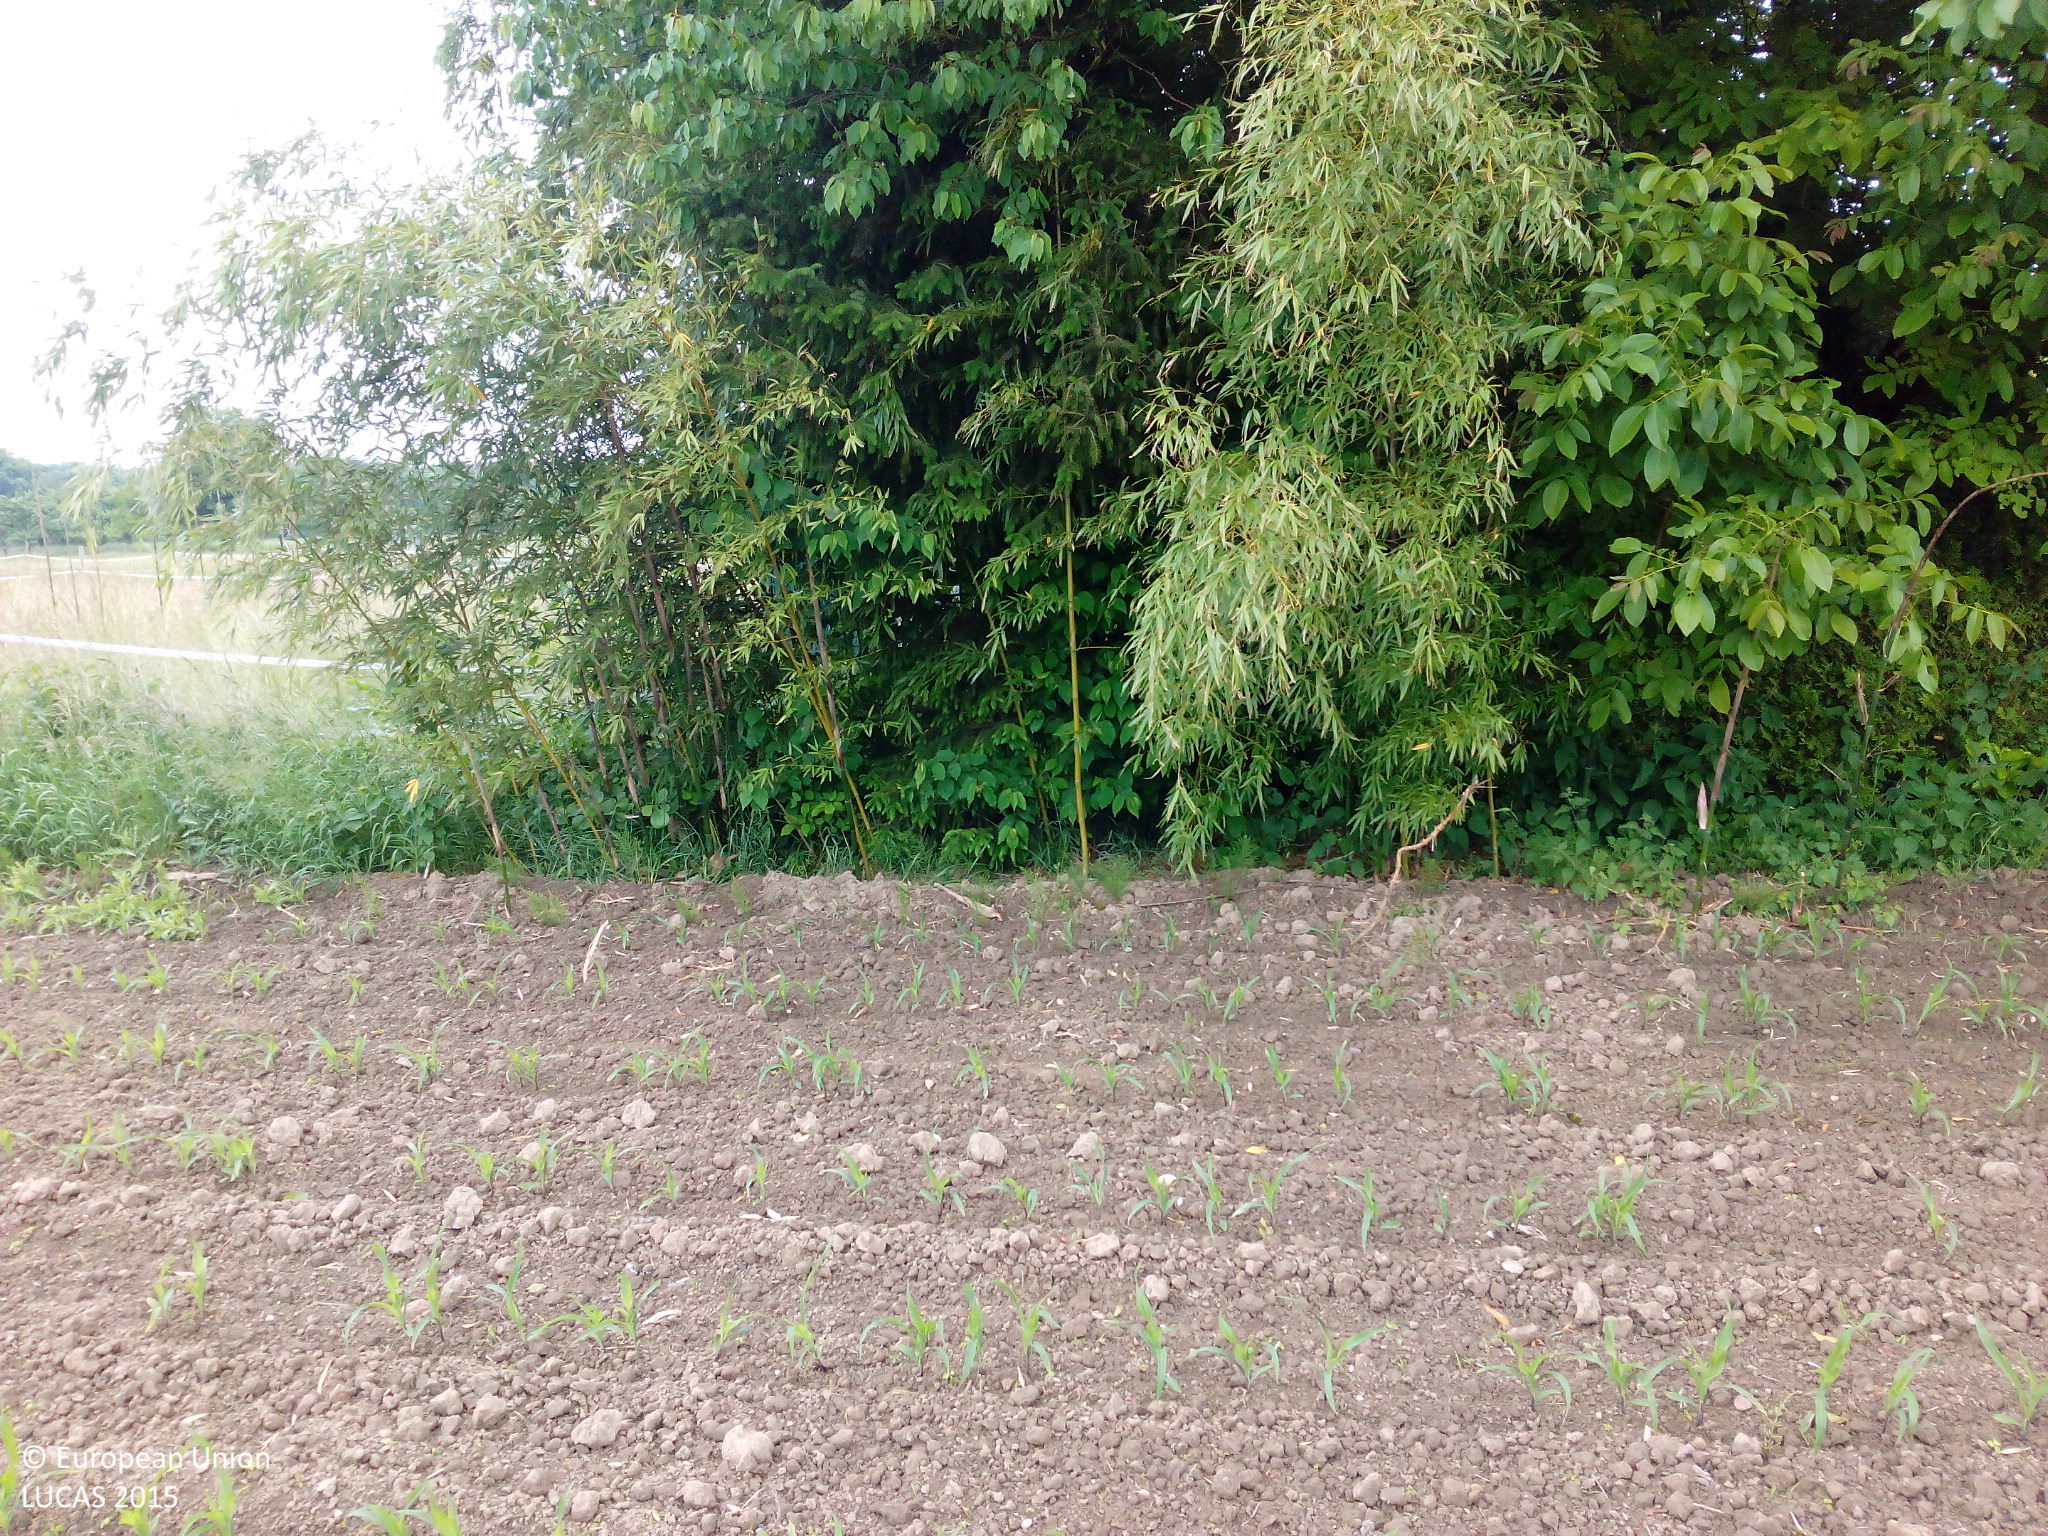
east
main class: Cropland
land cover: Maize
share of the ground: < 10 %
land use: Agriculture (excluding fallow land and kitchen gardens)
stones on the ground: < 10 %
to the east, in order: Maize; Broadleaved woodland; Fences; Grassland without tree/shrub cover; Fences; Paved roads, cycling and walking lanes; Common wheat; Apple fruit; Maize; Grassland without tree/shrub cover; Maize; Grassland with sparse tree/shrub cover; Rye; Grassland without tree/shrub cover; Maize
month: May
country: DE
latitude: 48.8741
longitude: 8.1600
